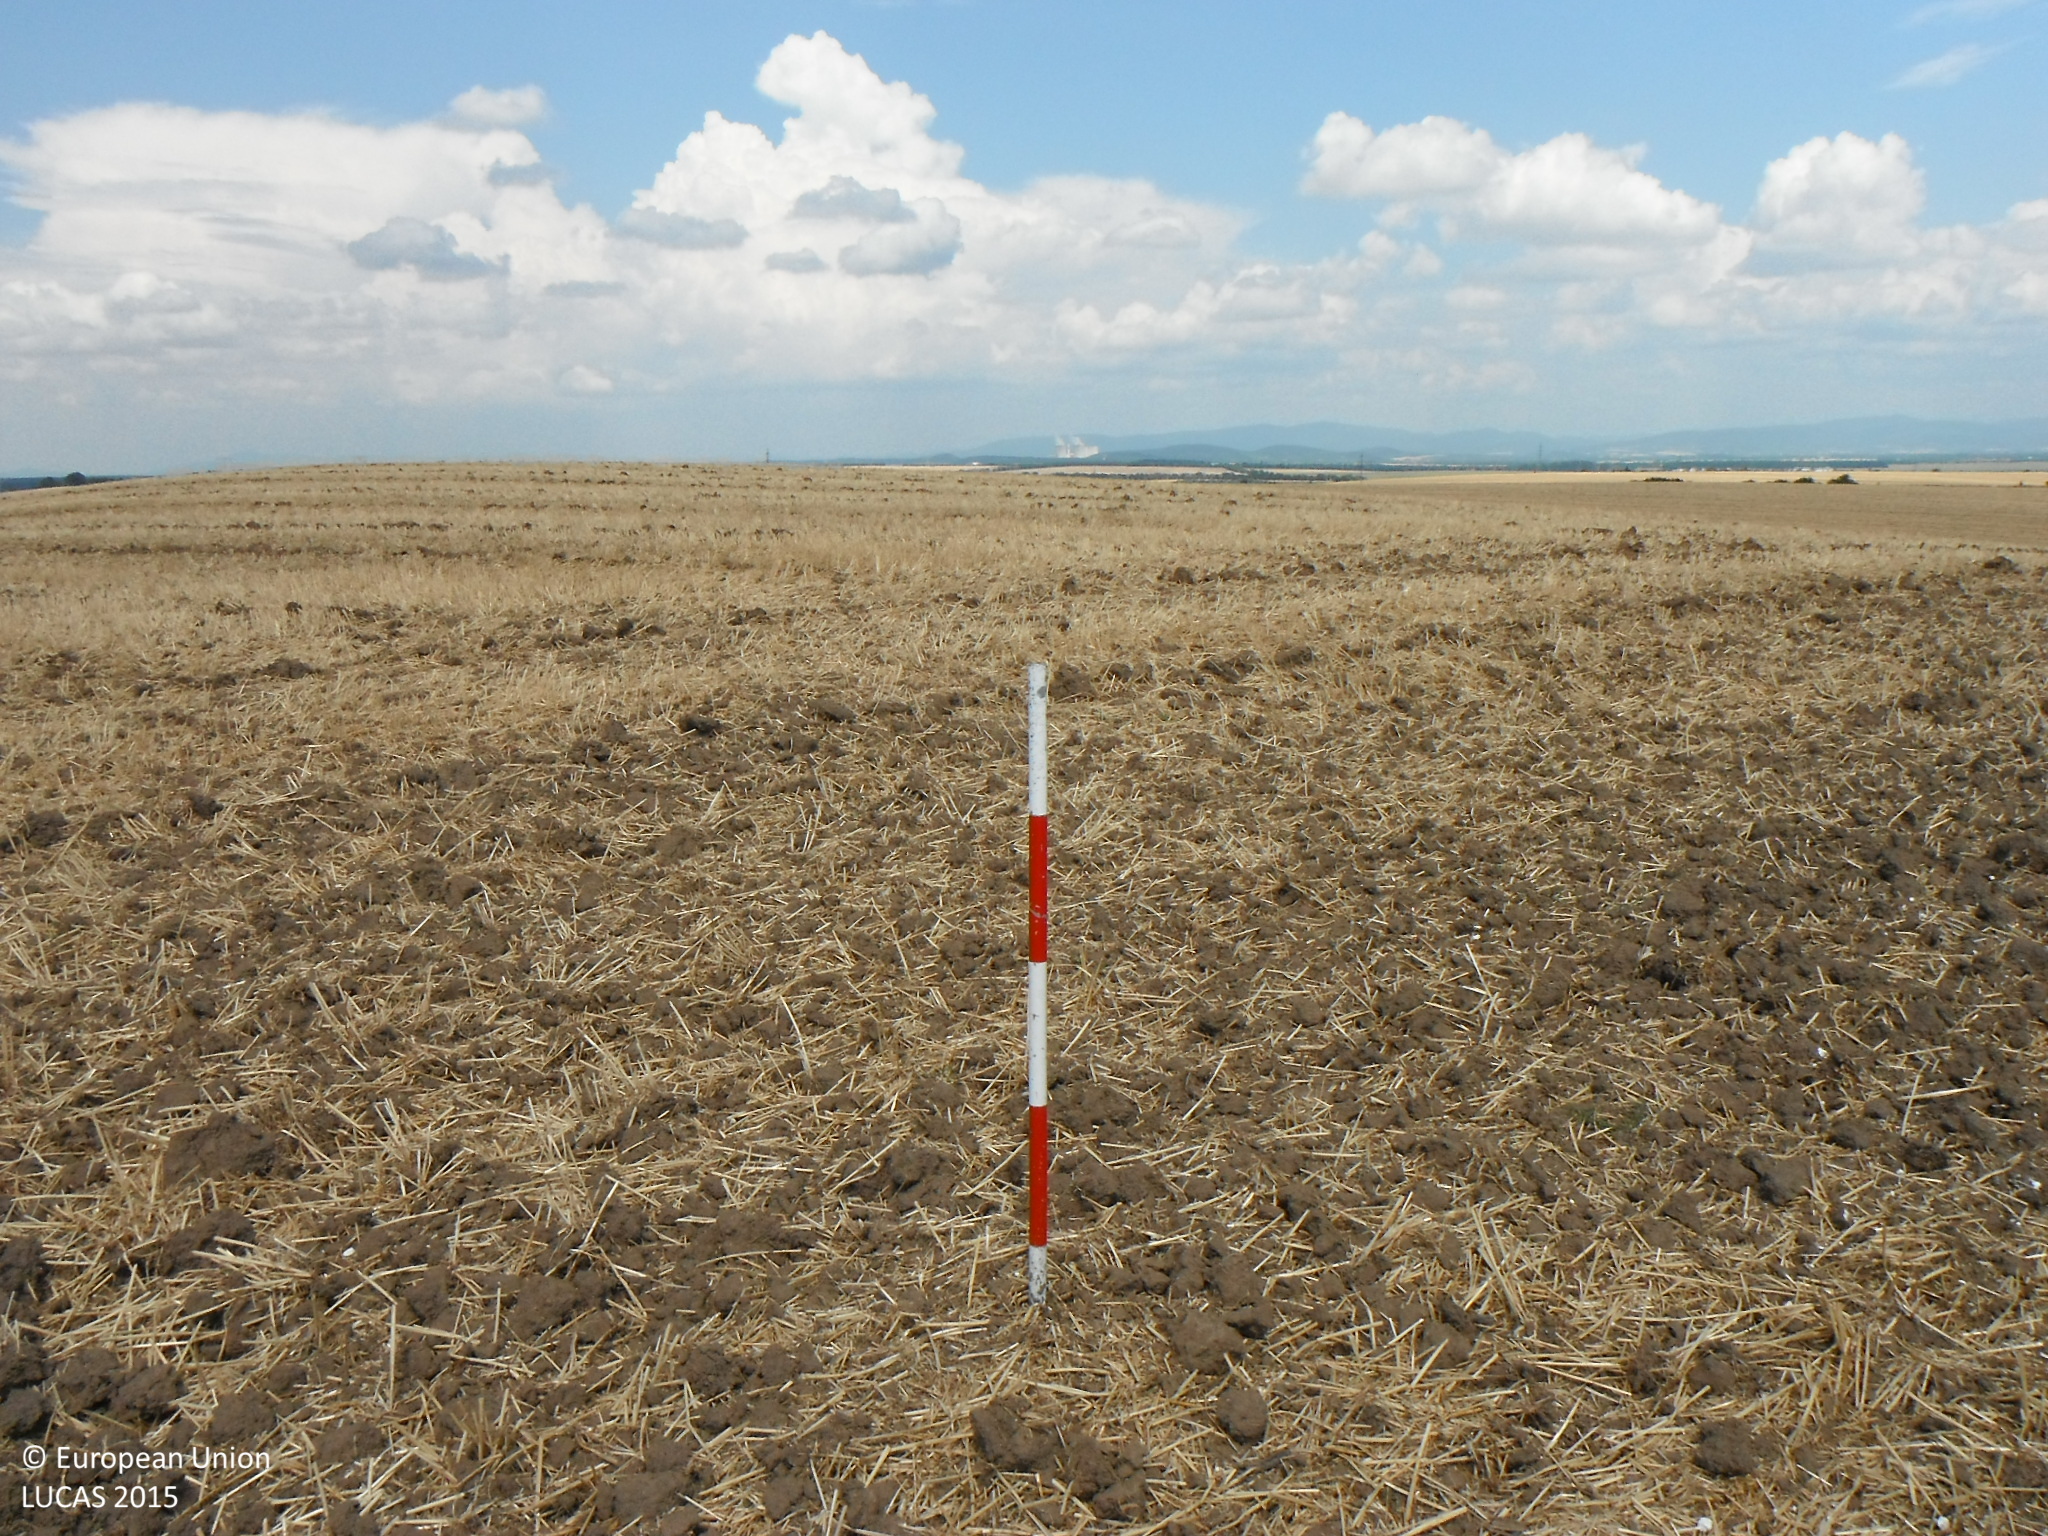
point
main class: Cropland
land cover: Common wheat
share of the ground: 10 - 25 %
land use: Agriculture (excluding fallow land and kitchen gardens)
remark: Harvested field
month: August
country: SK
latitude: 48.1346
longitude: 18.4408
